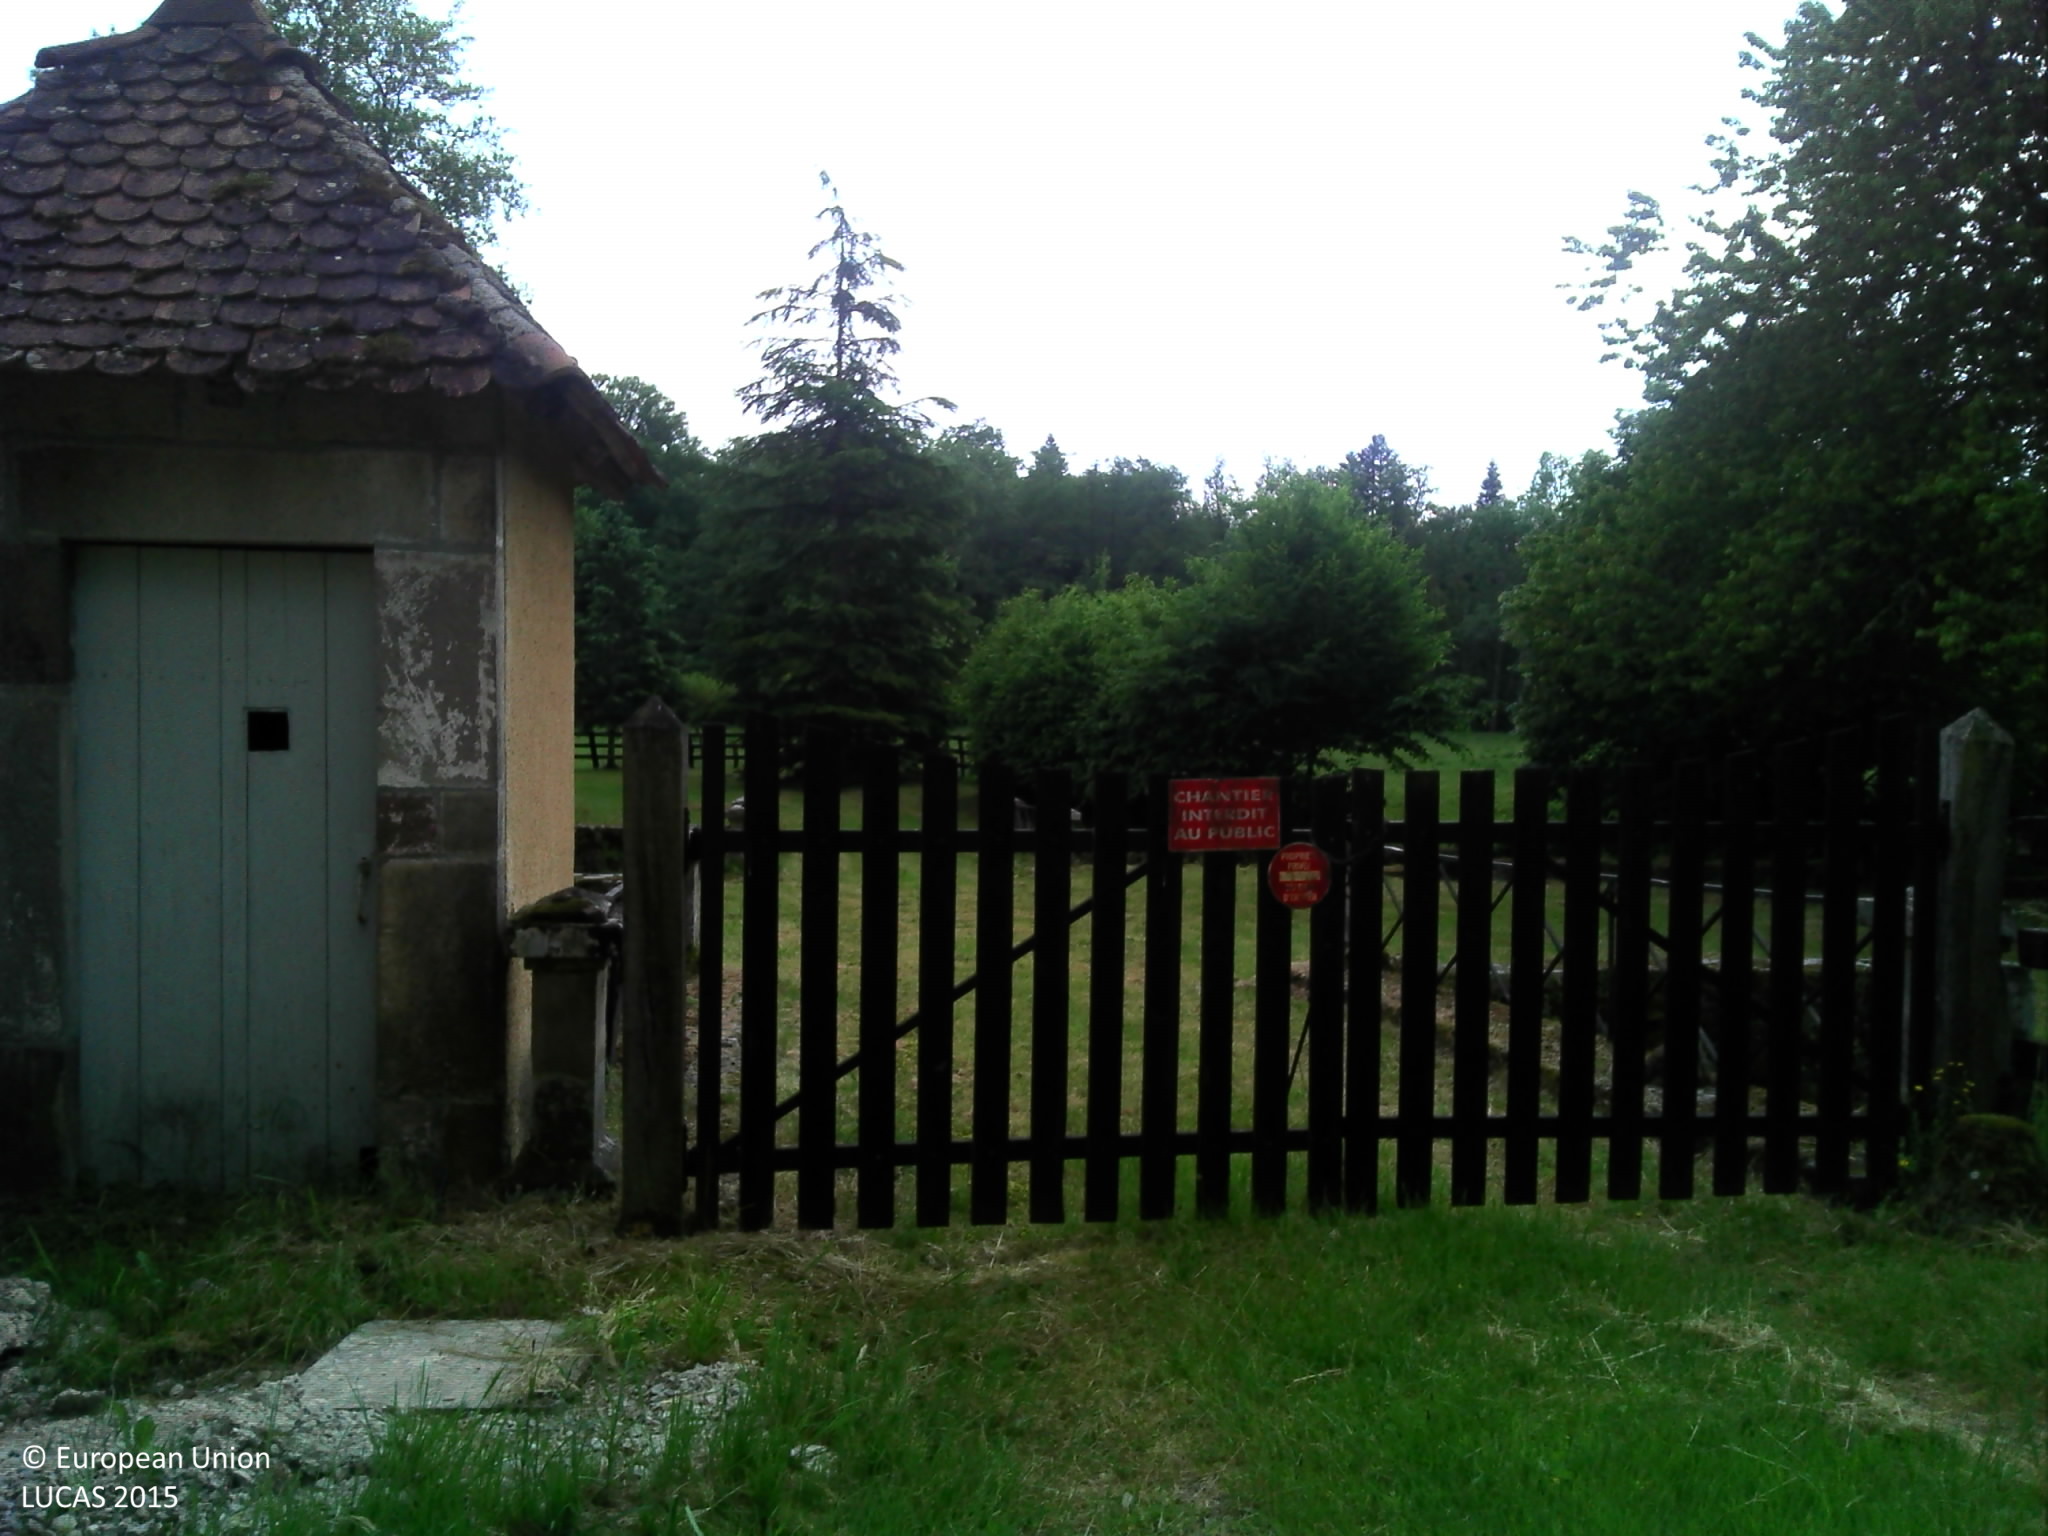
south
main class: Grassland
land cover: Grassland without tree/shrub cover
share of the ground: > 75 %
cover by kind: herbaceous plants 90 %, unconsolidated bare surface 10 %
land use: Road transport
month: May
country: FR
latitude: 47.9575
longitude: 6.1306
